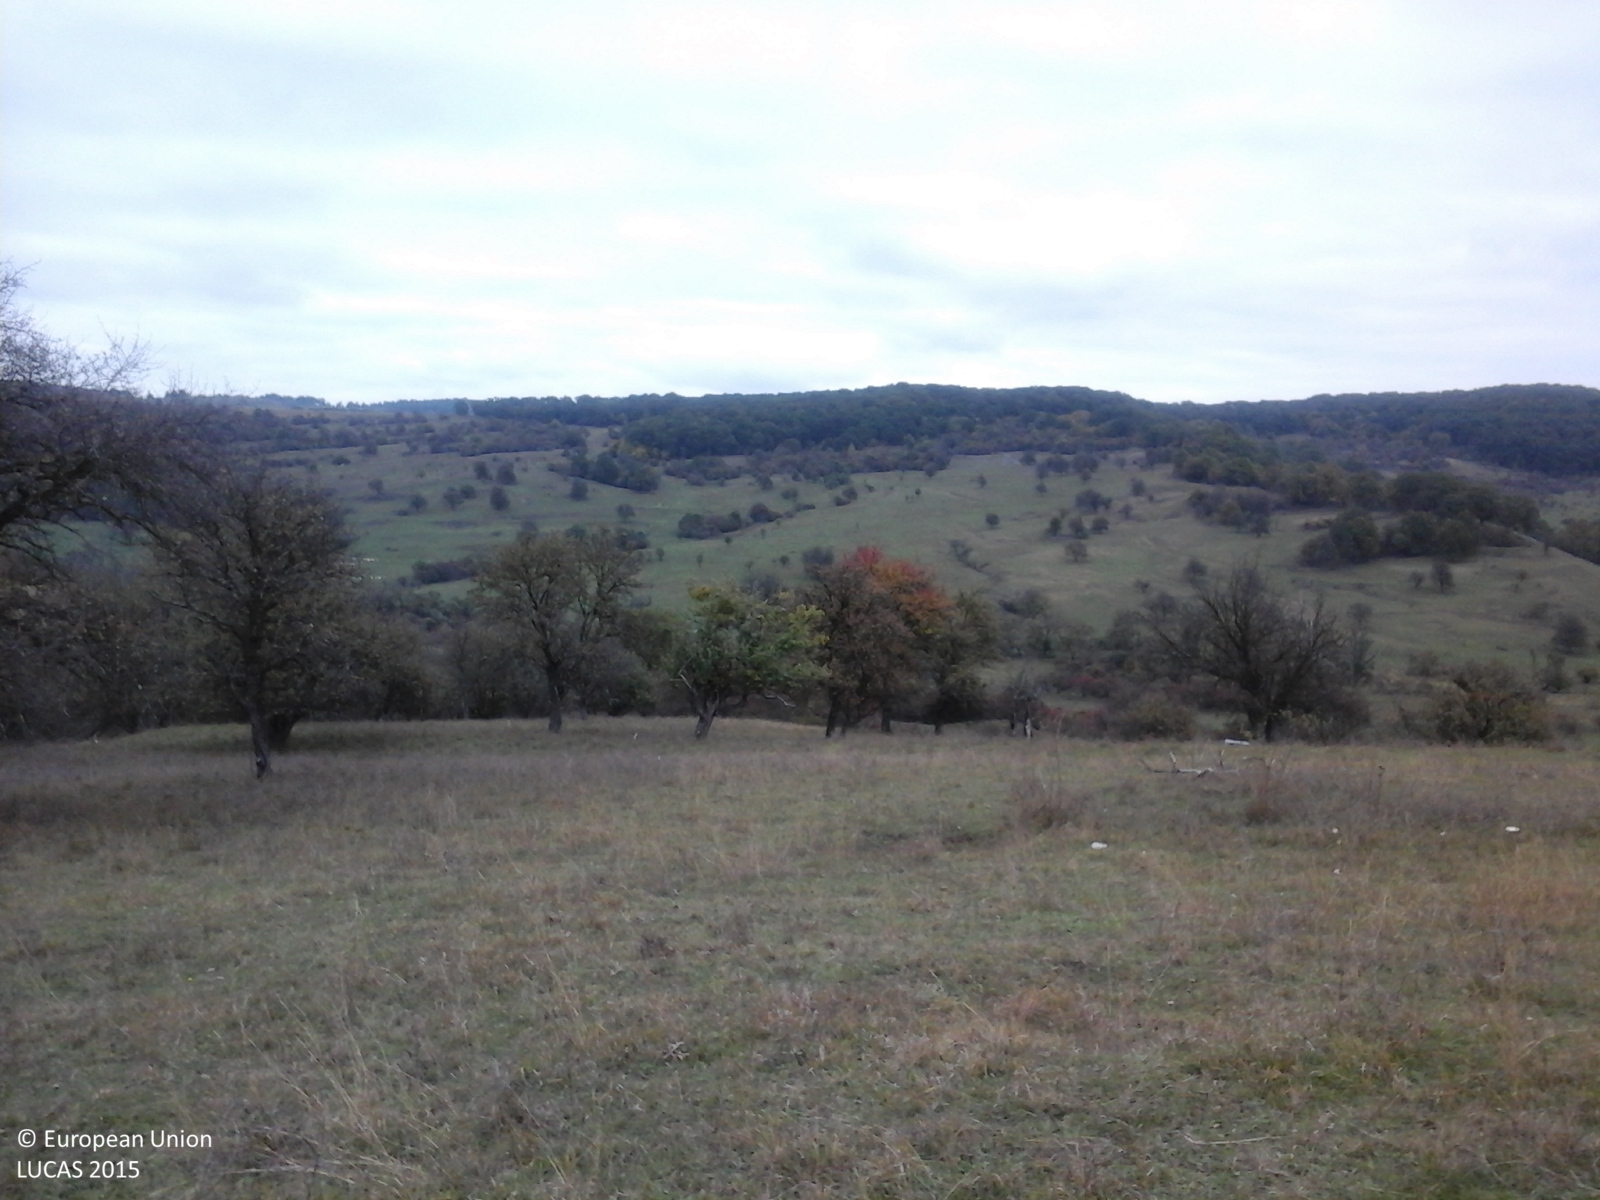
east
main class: Grassland
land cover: Grassland with sparse tree/shrub cover
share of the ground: > 75 %
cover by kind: herbaceous plants 95 %, broadleaved forest trees 5 %
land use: Agriculture (excluding fallow land and kitchen gardens)
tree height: > 5 m
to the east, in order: Grassland with sparse tree/shrub cover; Broadleaved woodland; Grassland with sparse tree/shrub cover
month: October
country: RO
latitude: 45.9501
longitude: 24.8355
